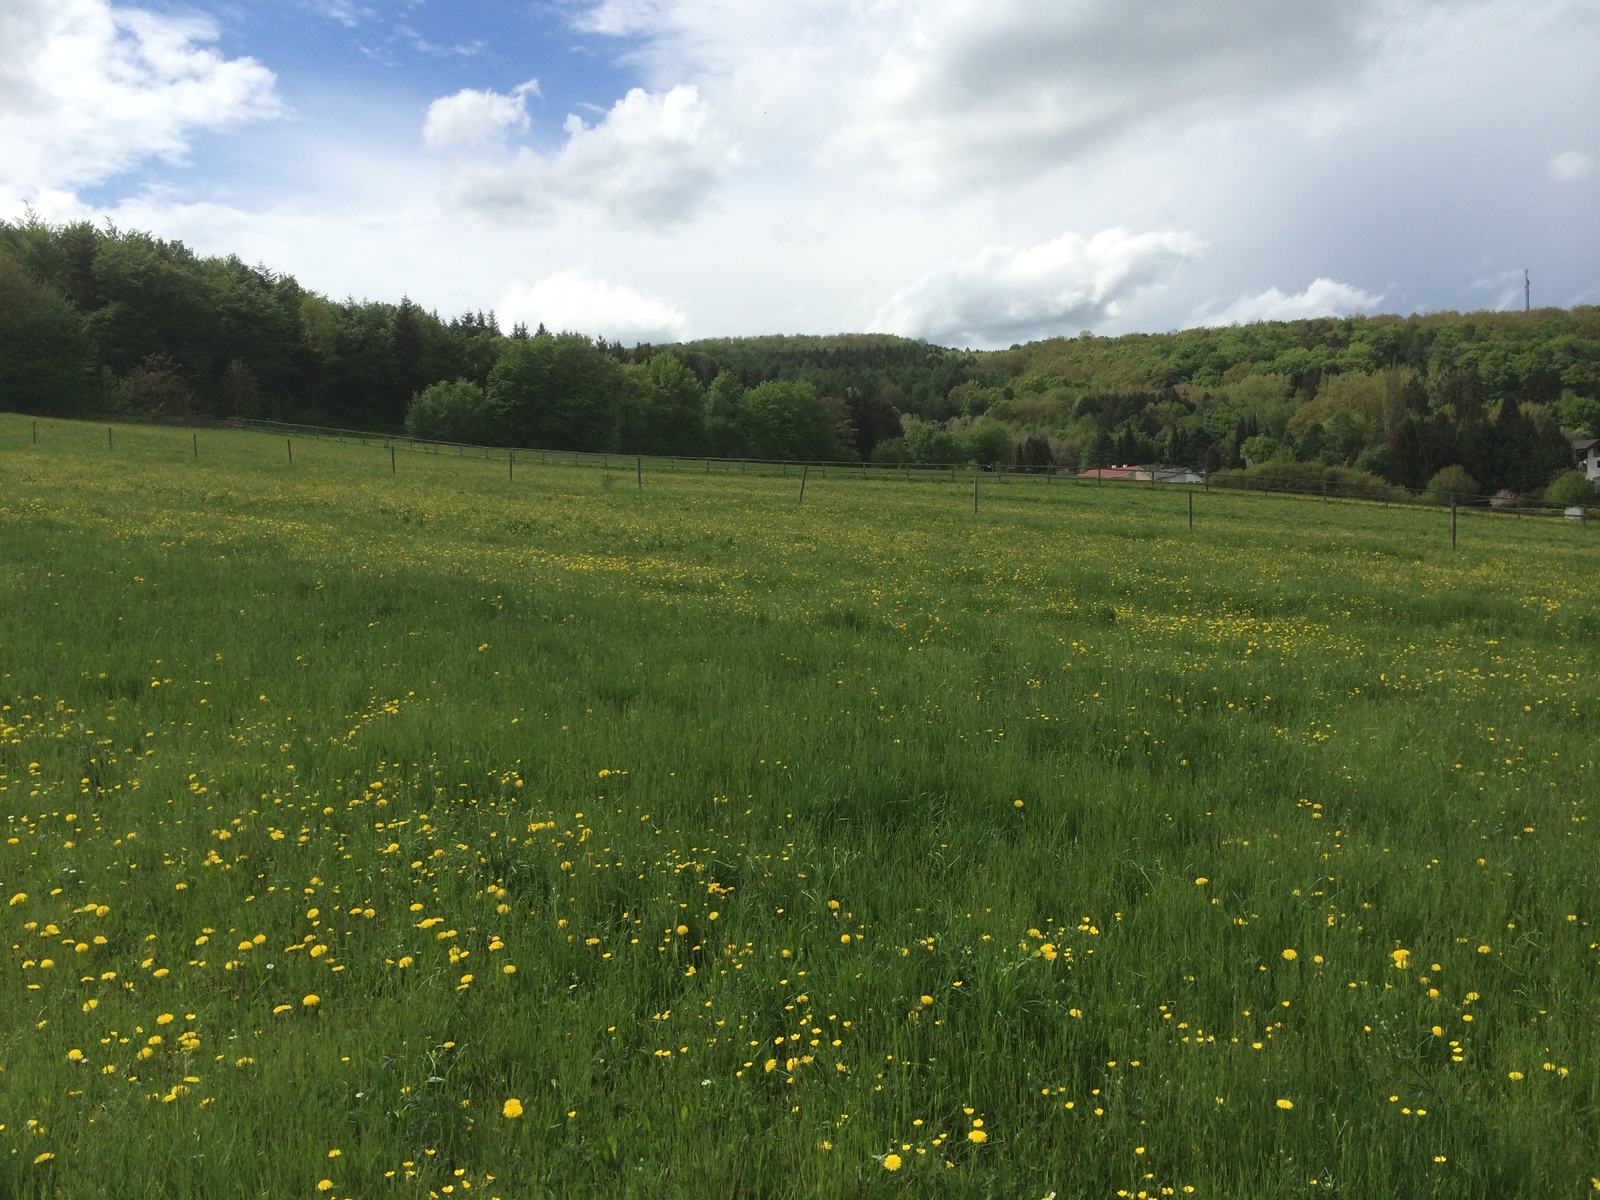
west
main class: Grassland
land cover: Grassland without tree/shrub cover
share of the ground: > 75 %
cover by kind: herbaceous plants 100 %
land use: Agriculture (excluding fallow land and kitchen gardens)
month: May
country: AT
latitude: 48.0691
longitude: 16.1640
